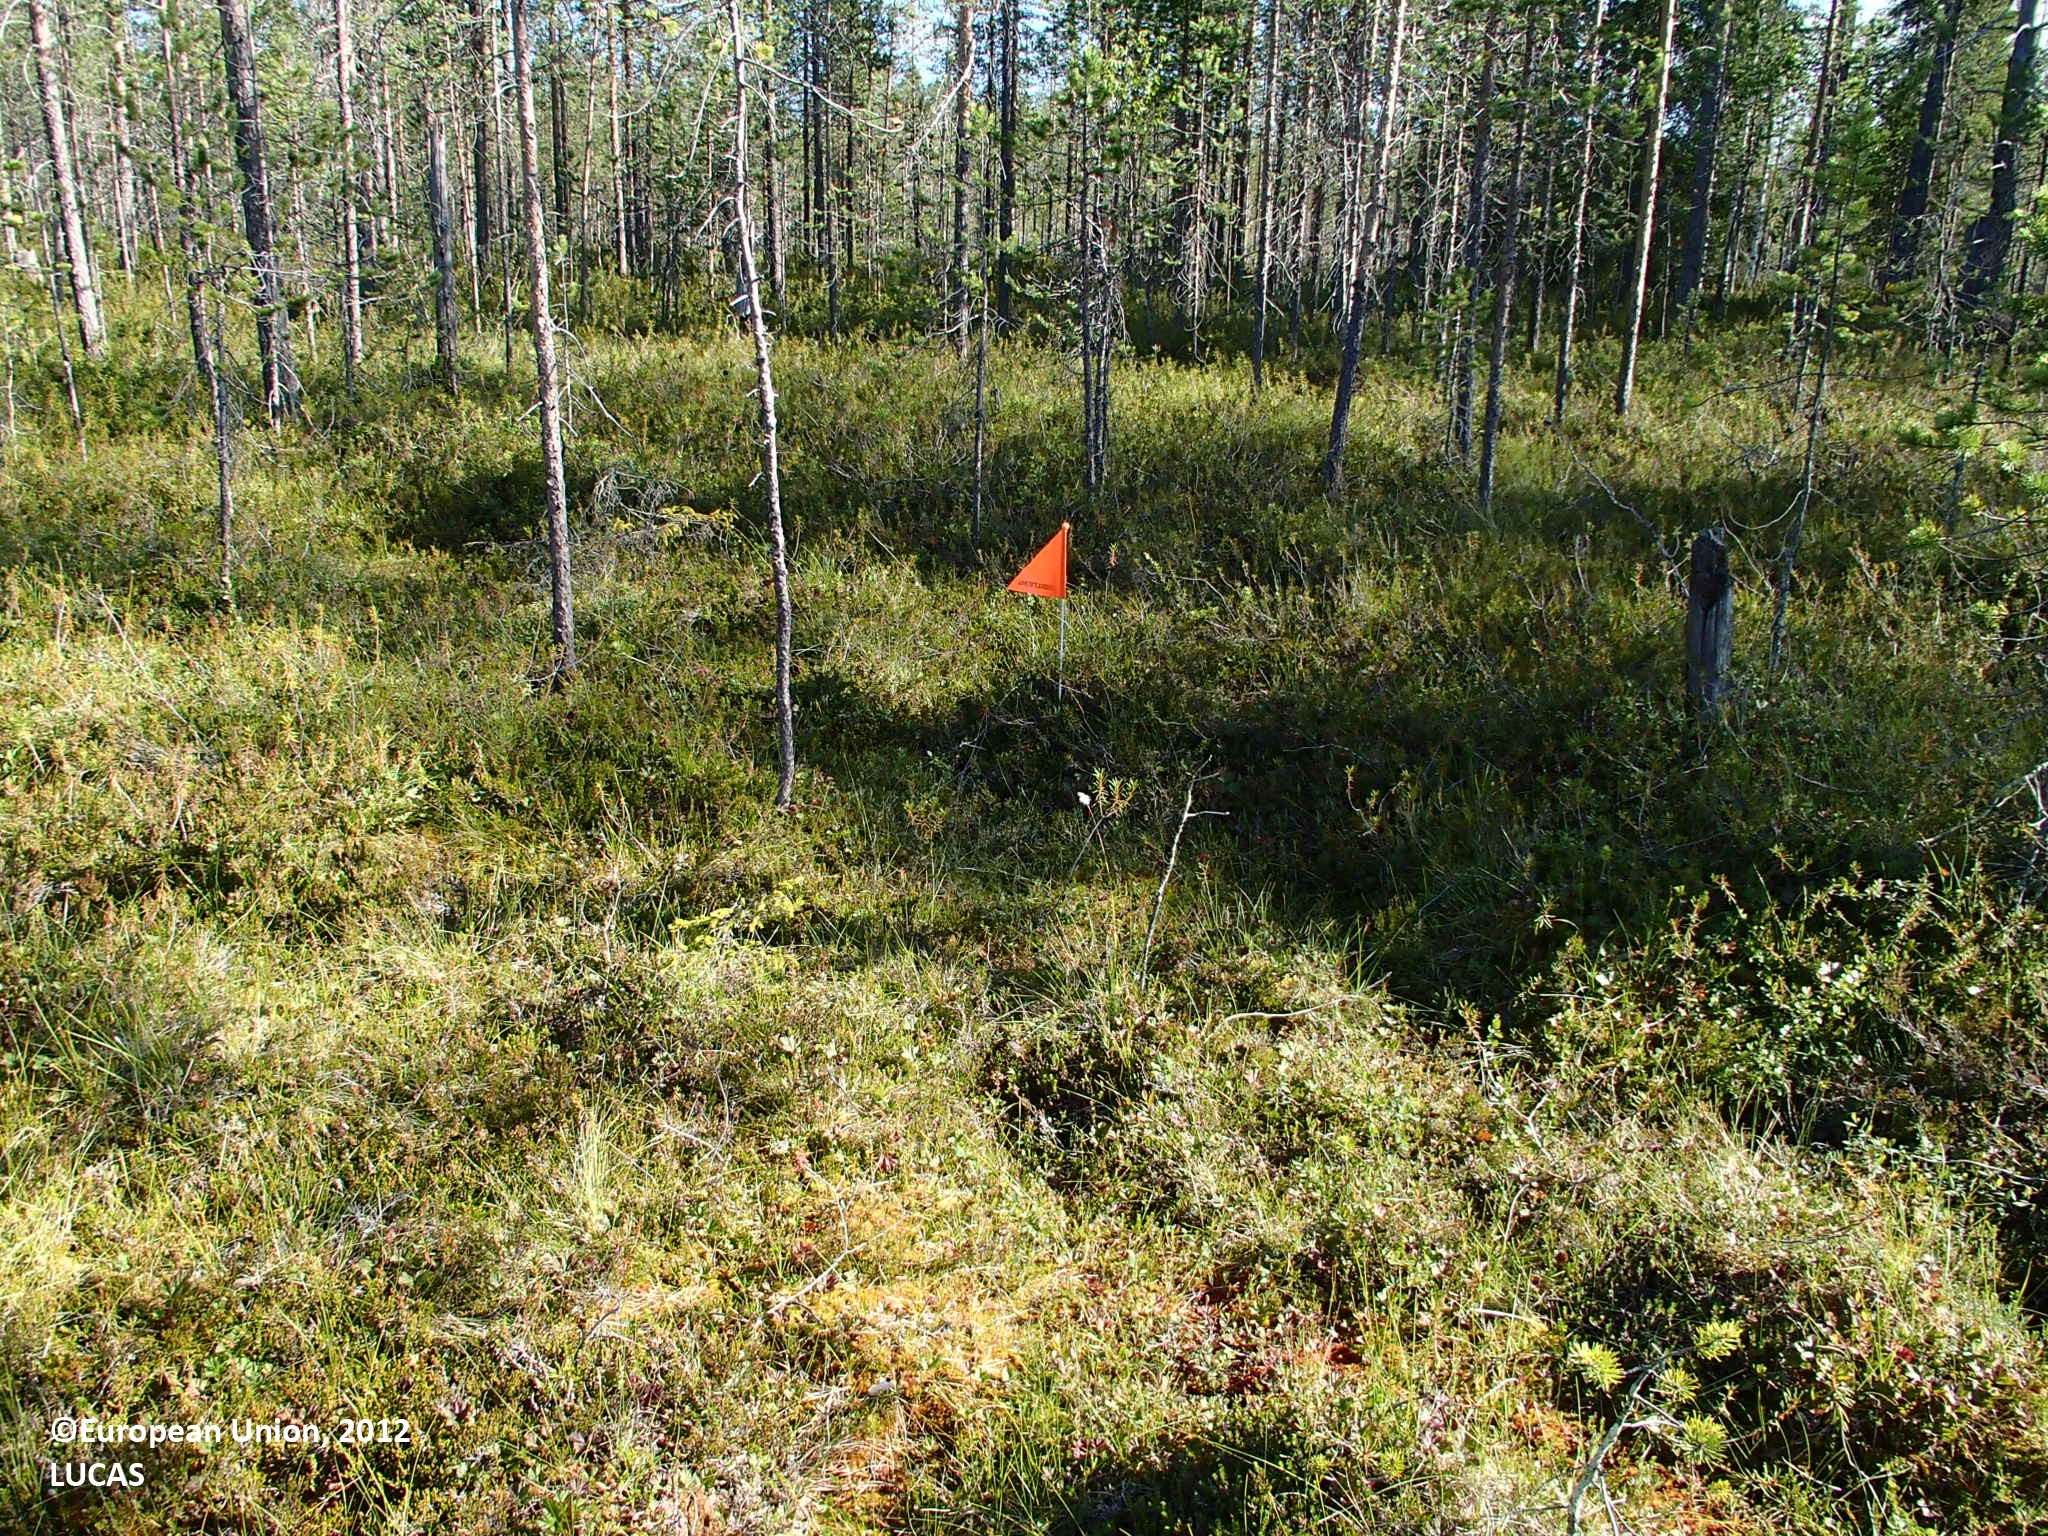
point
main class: Woodland
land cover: Pine dominated coniferous woodland
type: boreal forest
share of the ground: 10 - 25 %
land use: Forestry
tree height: > 5 m
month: July
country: FI
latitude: 66.8268
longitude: 25.5688
